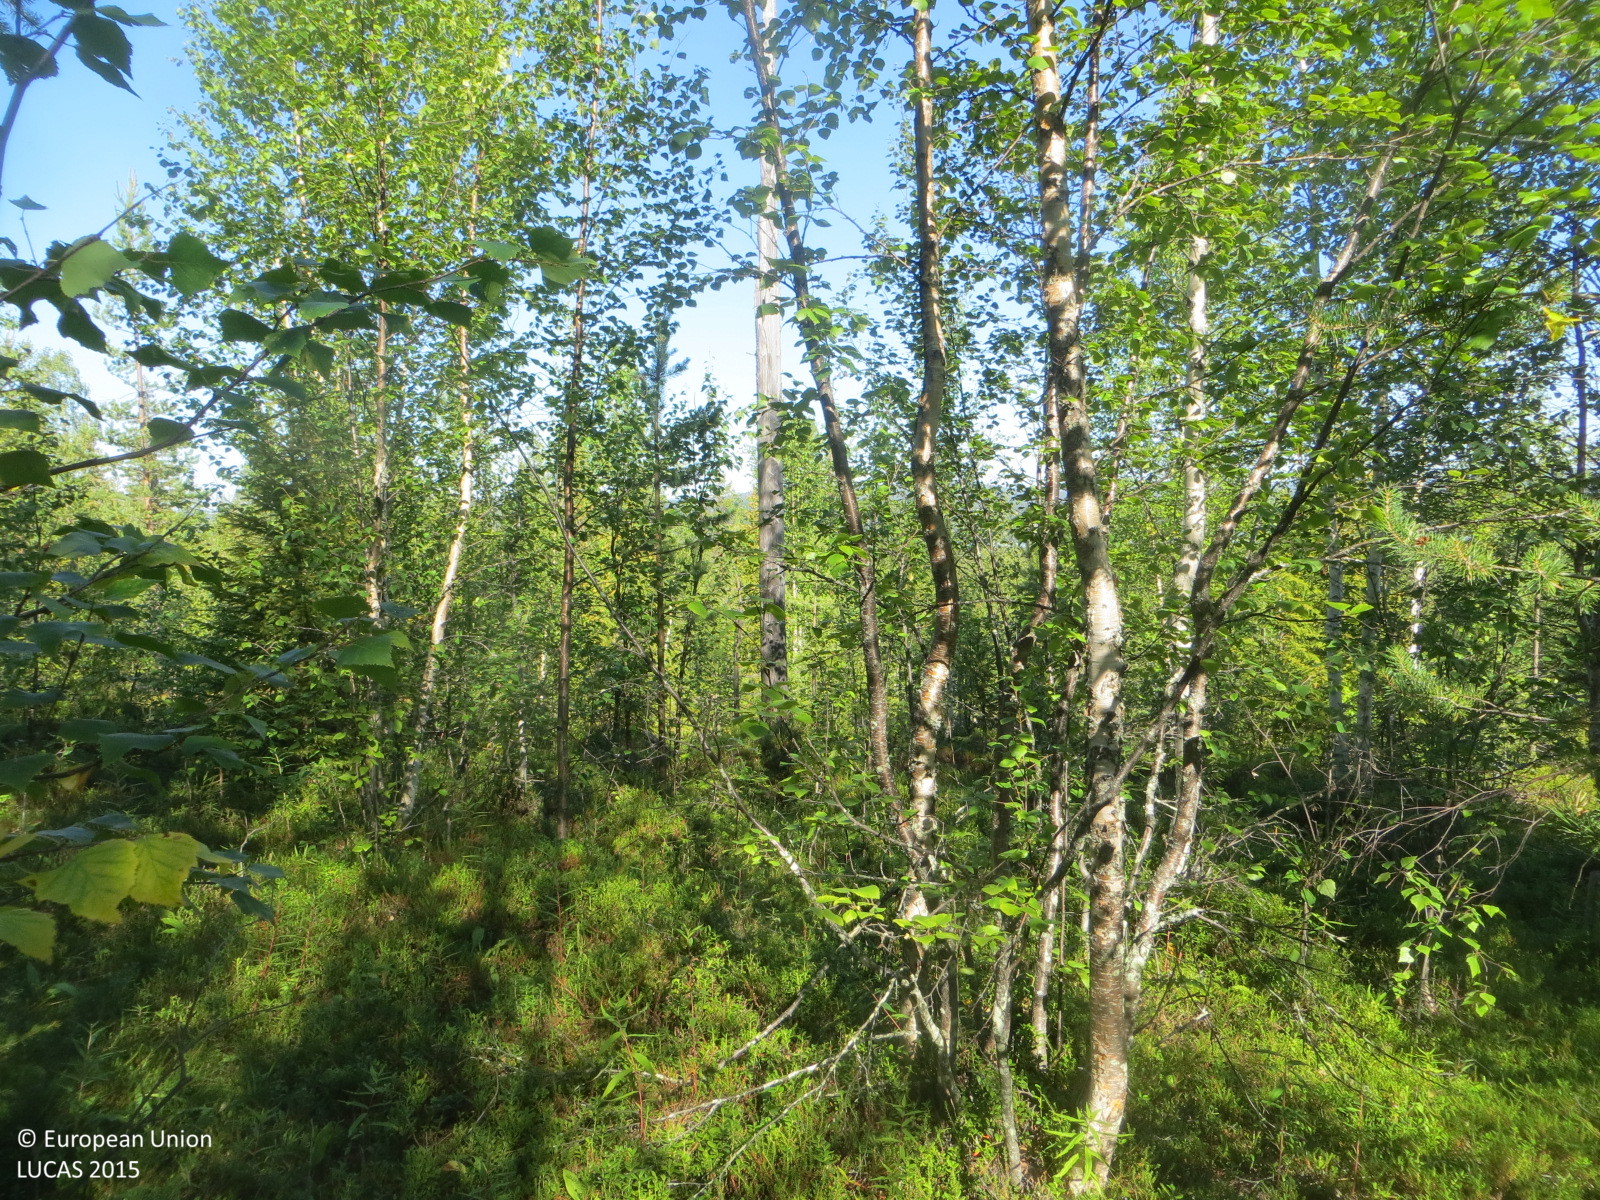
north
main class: Woodland
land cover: Pine dominated mixed woodland
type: boreal forest
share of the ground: 50 - 75 %
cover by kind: shrubs 40 %, broadleaved forest trees 35 %, coniferous forest trees 25 %
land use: Forestry
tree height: > 5 m
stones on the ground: 25 - 50 %
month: August
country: FI
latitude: 67.1941
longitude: 24.1083
